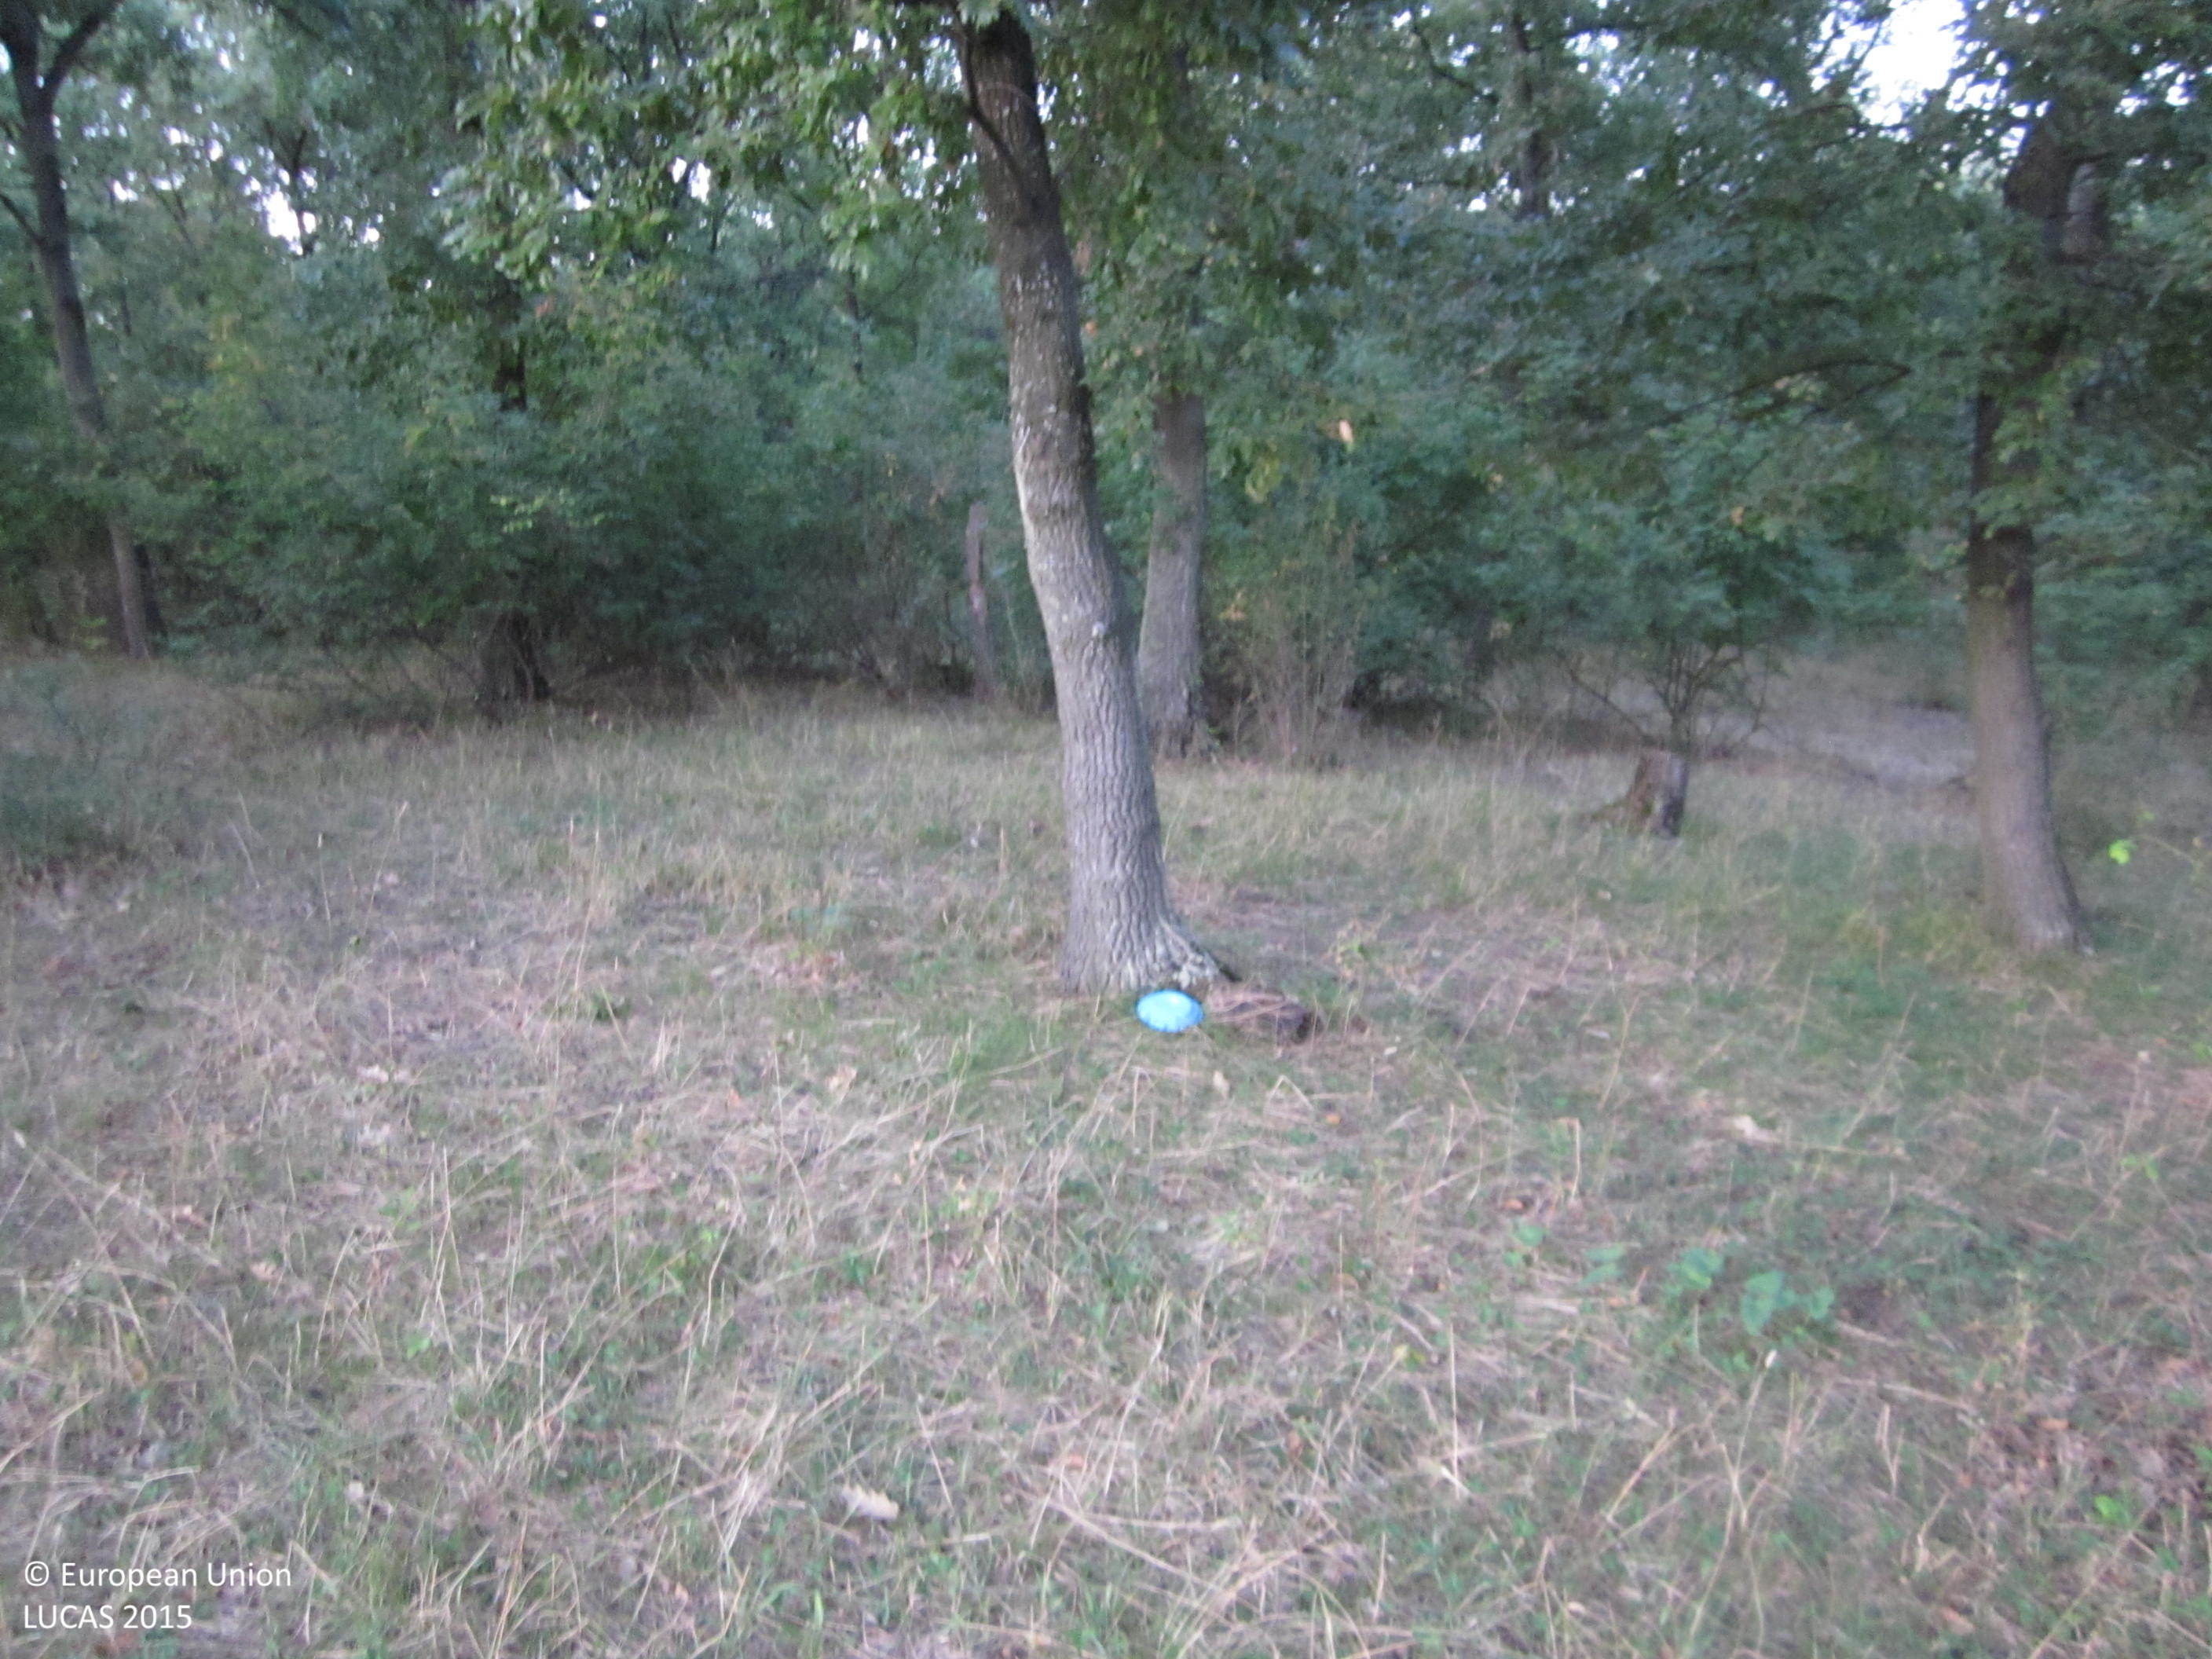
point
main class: Woodland
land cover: Broadleaved woodland
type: thermophilous deciduous forest
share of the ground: 50 - 75 %
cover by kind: broadleaved forest trees 70 %, herbaceous plants 30 %
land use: Forestry
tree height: > 5 m
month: September
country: BG
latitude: 42.6599
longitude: 27.1035
